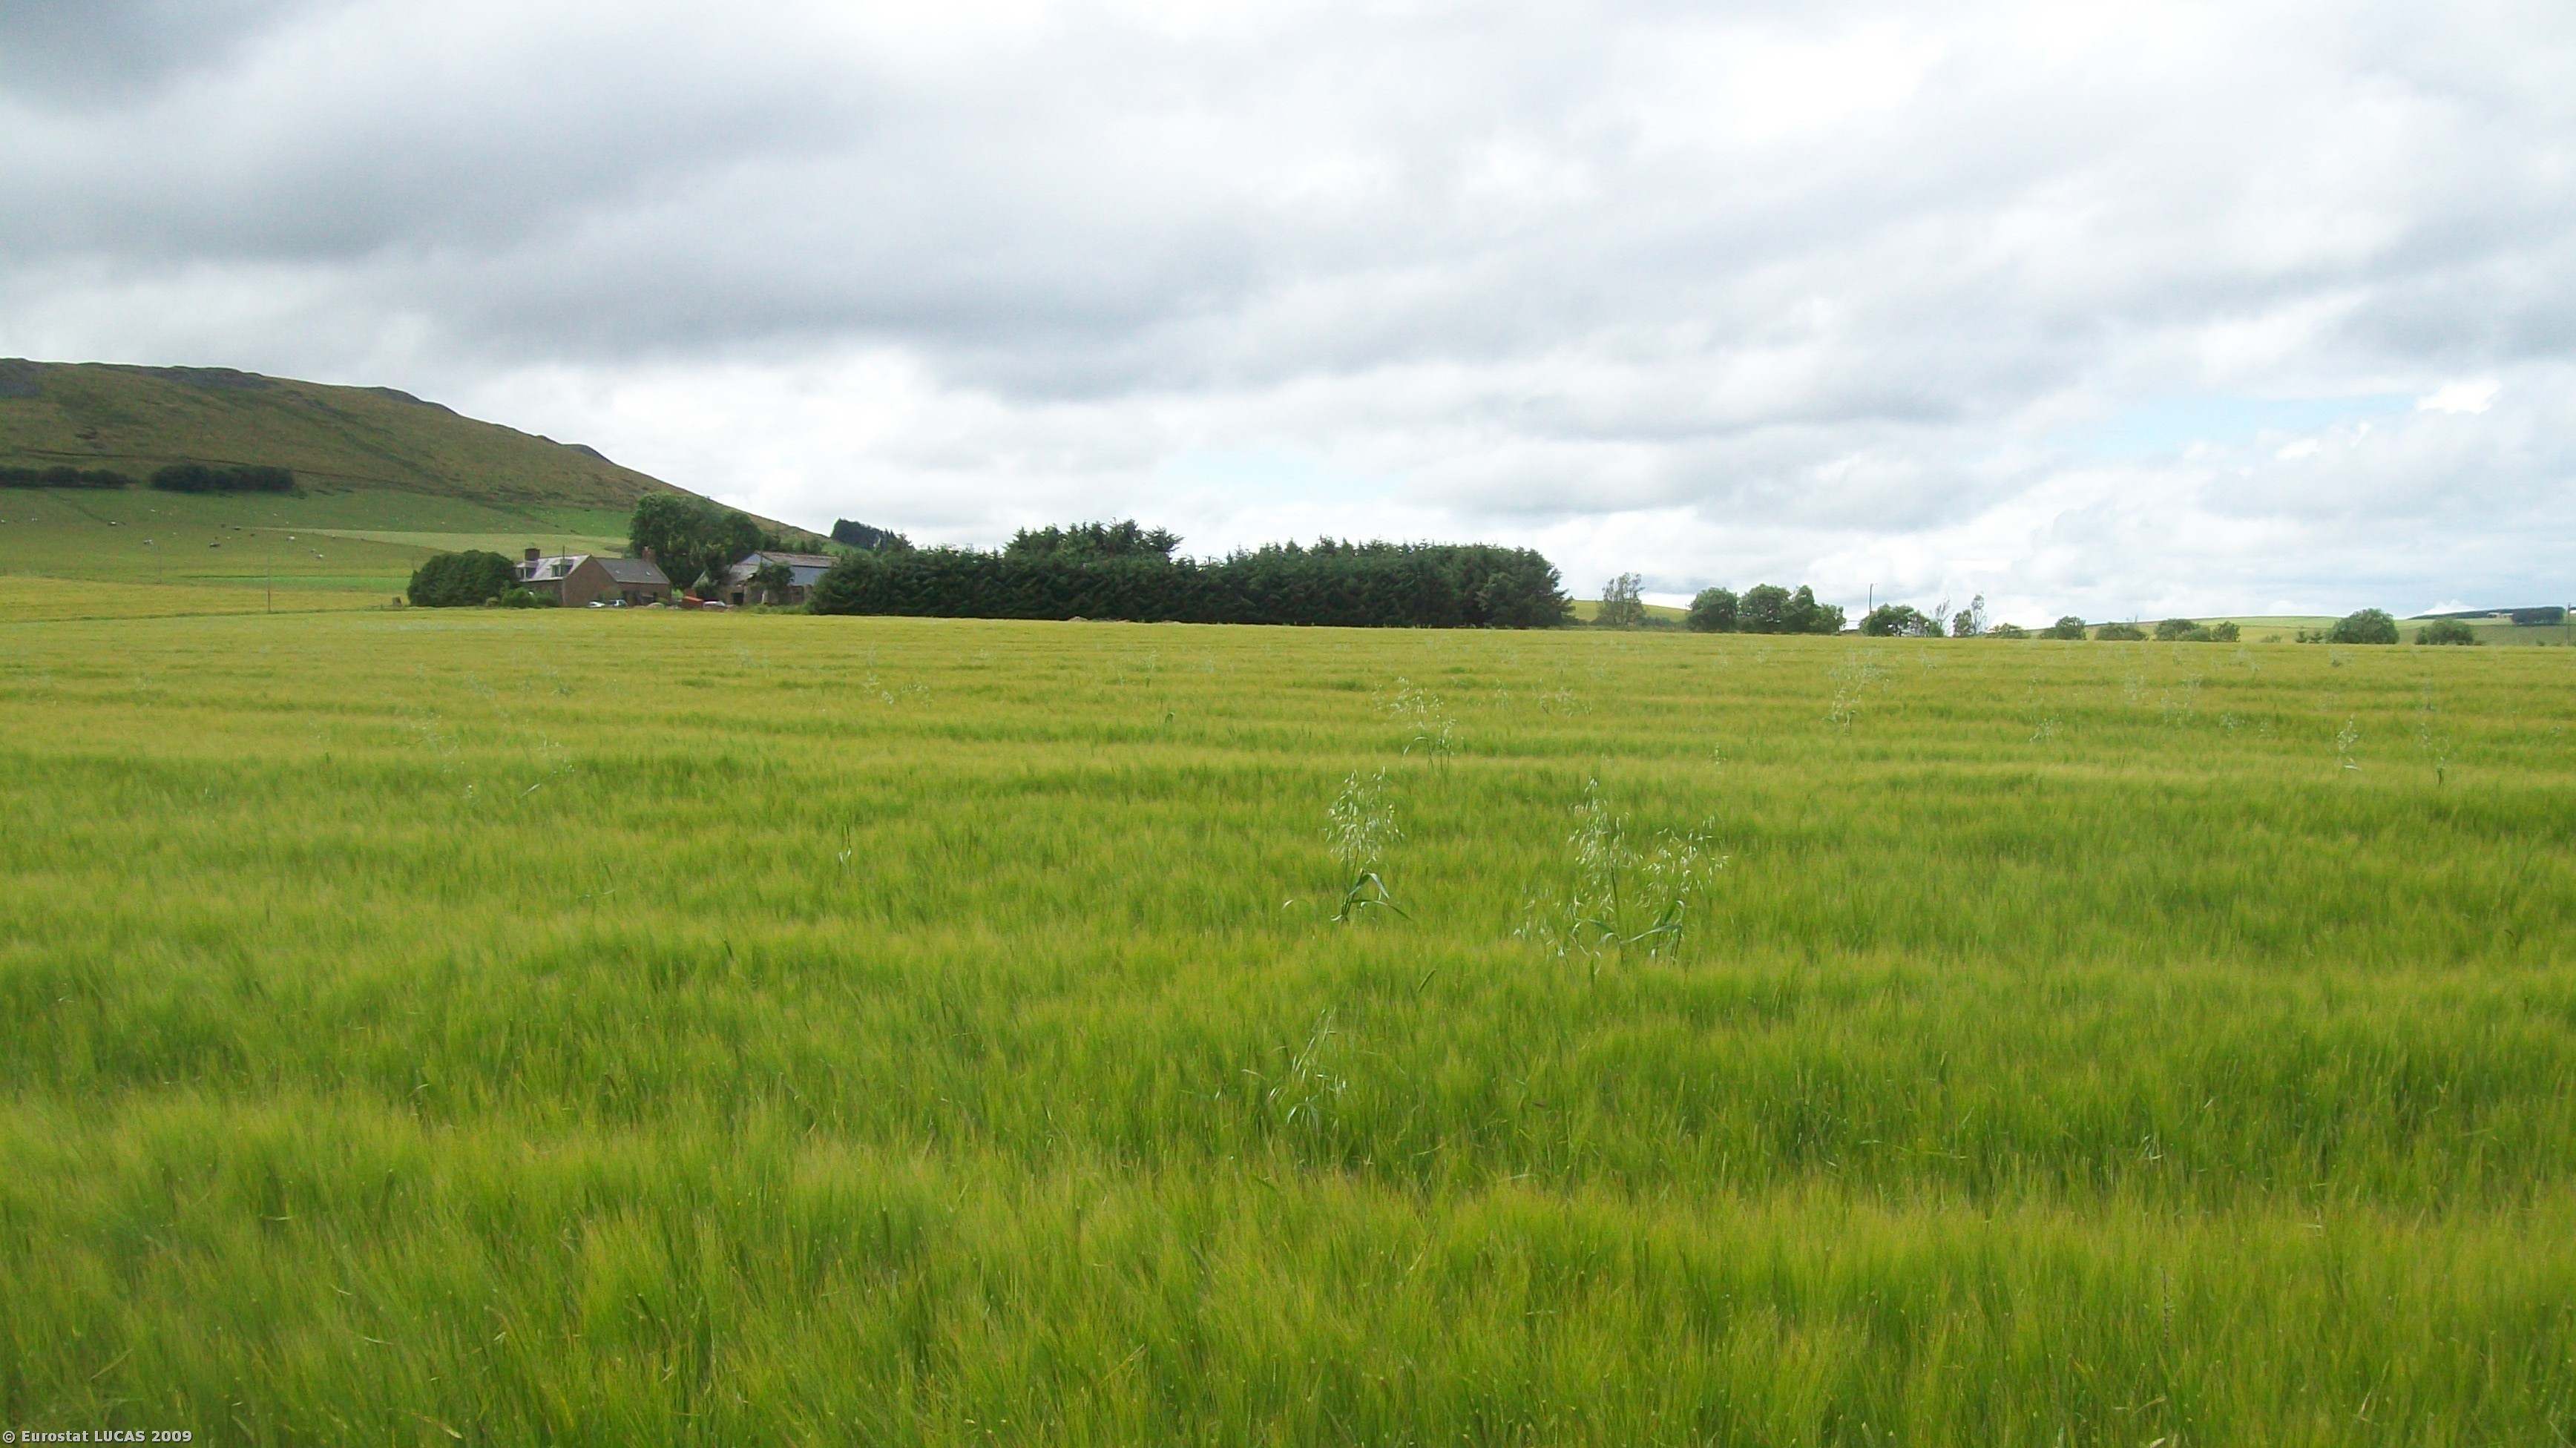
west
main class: Cropland
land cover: Barley
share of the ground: > 75 %
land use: Agriculture (excluding fallow land and kitchen gardens)
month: July
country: GB
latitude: 57.4090
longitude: -2.5551
